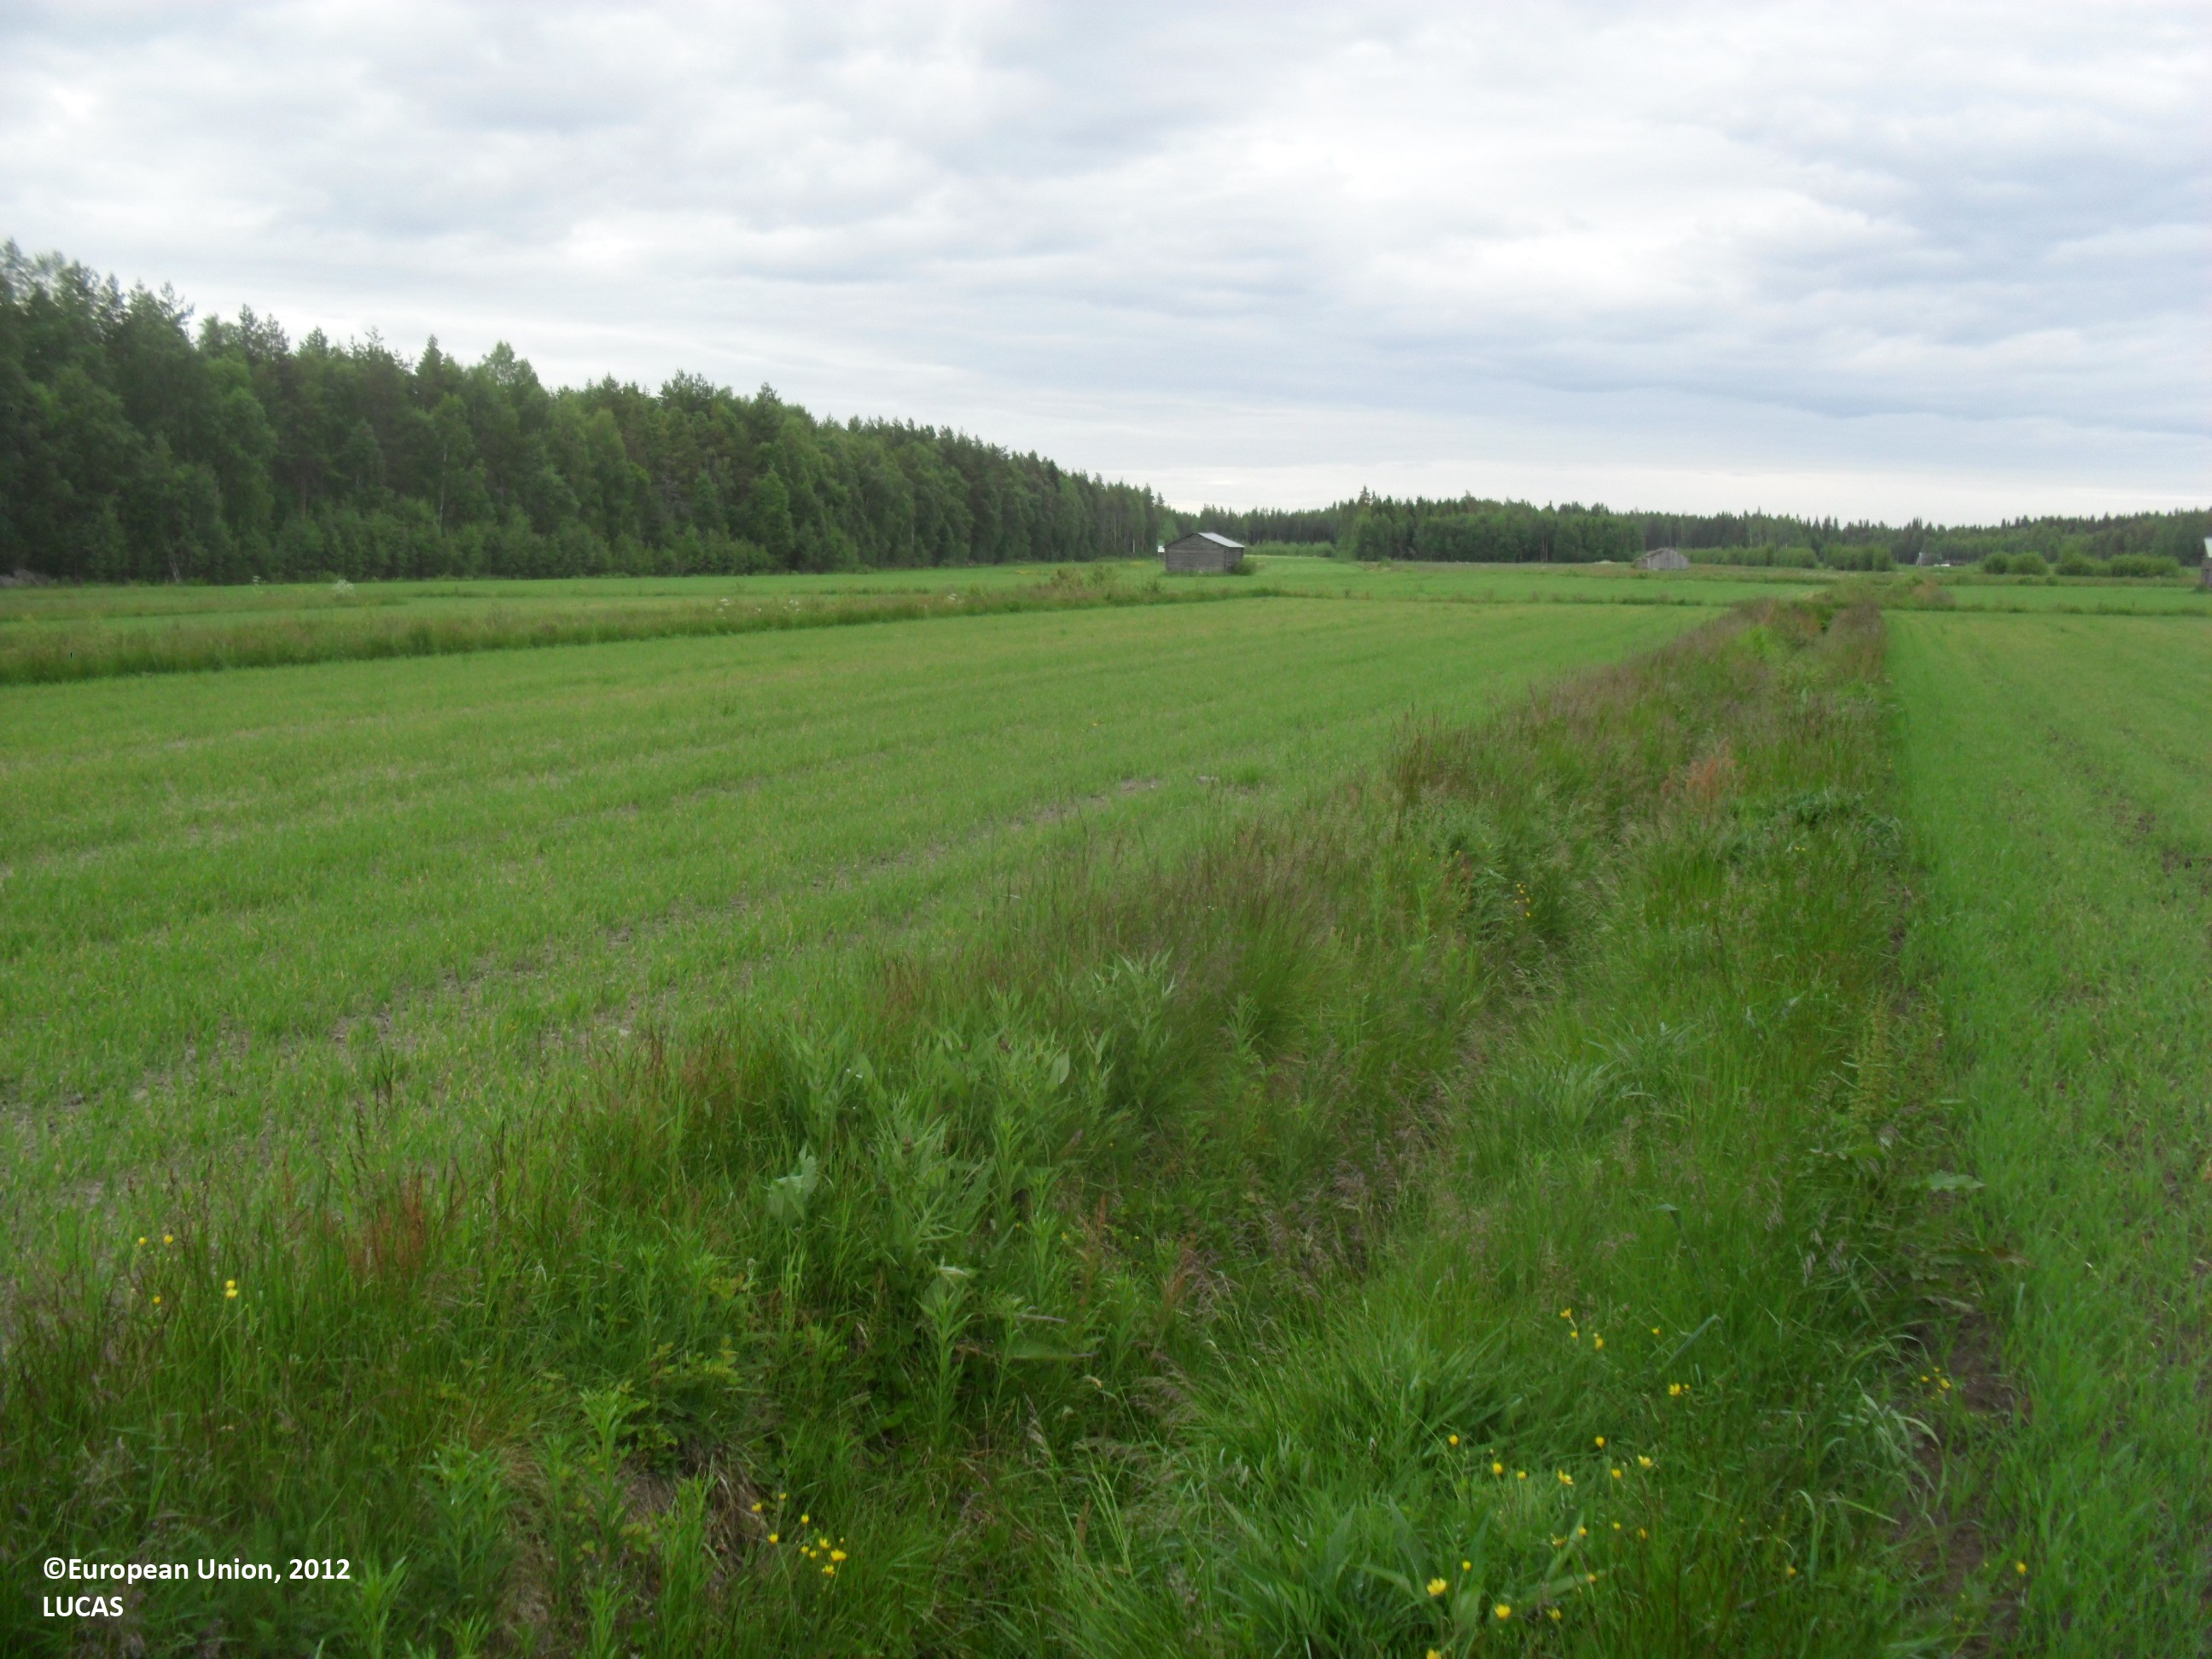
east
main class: Cropland
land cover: Barley
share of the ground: 10 - 25 %
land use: Agriculture (excluding fallow land and kitchen gardens)
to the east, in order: Barley; Ditches and canals; Barley; Grass margins; Rivers and streams; Spontaneously vegetated surfaces; Barley; Grass margins; Rivers and streams; Barley; Rivers and streams; Other mixed woodland
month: June
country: FI
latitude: 63.4898
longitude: 23.0472
